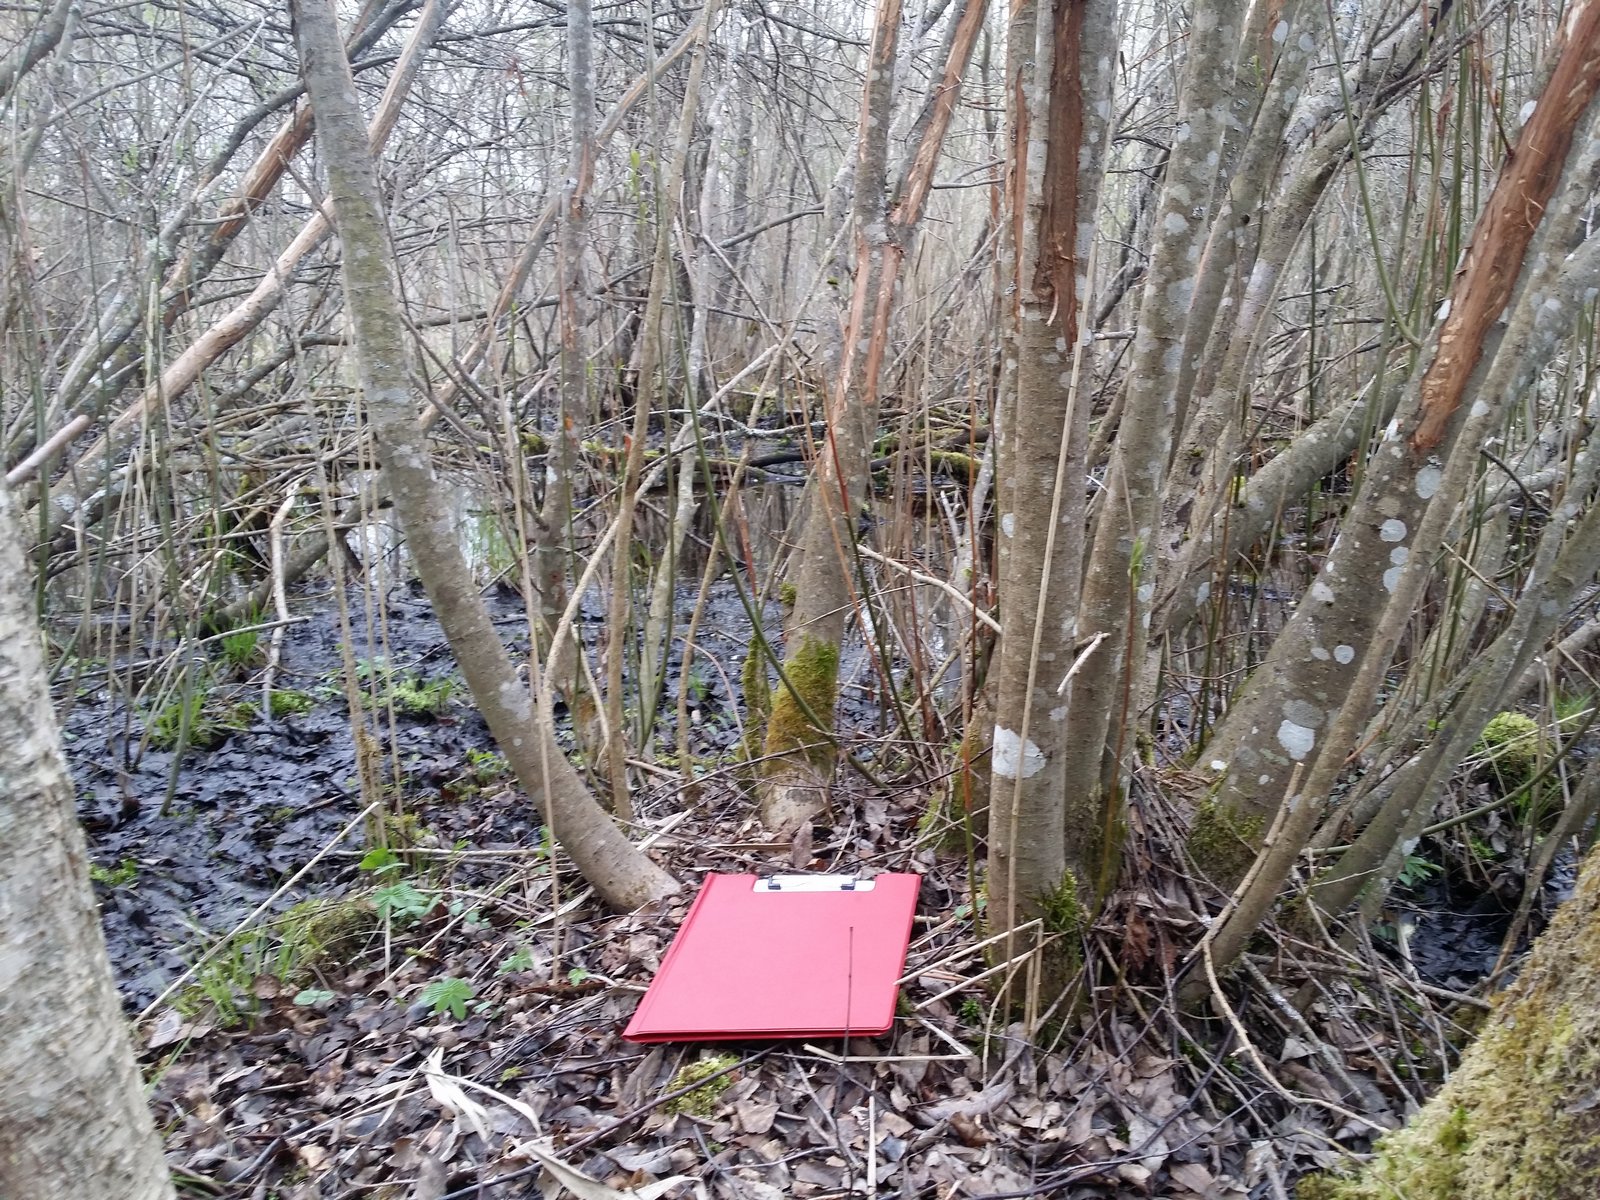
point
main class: Woodland
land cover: Broadleaved woodland
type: mire and swamp forests
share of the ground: > 75 %
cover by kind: broadleaved forest trees 70 %, coniferous forest trees 20 %, lichens and mosses 10 %
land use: Semi-natural and natural areas not in use
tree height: < 5 m
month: May
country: LV
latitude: 57.4697
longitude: 26.0188
